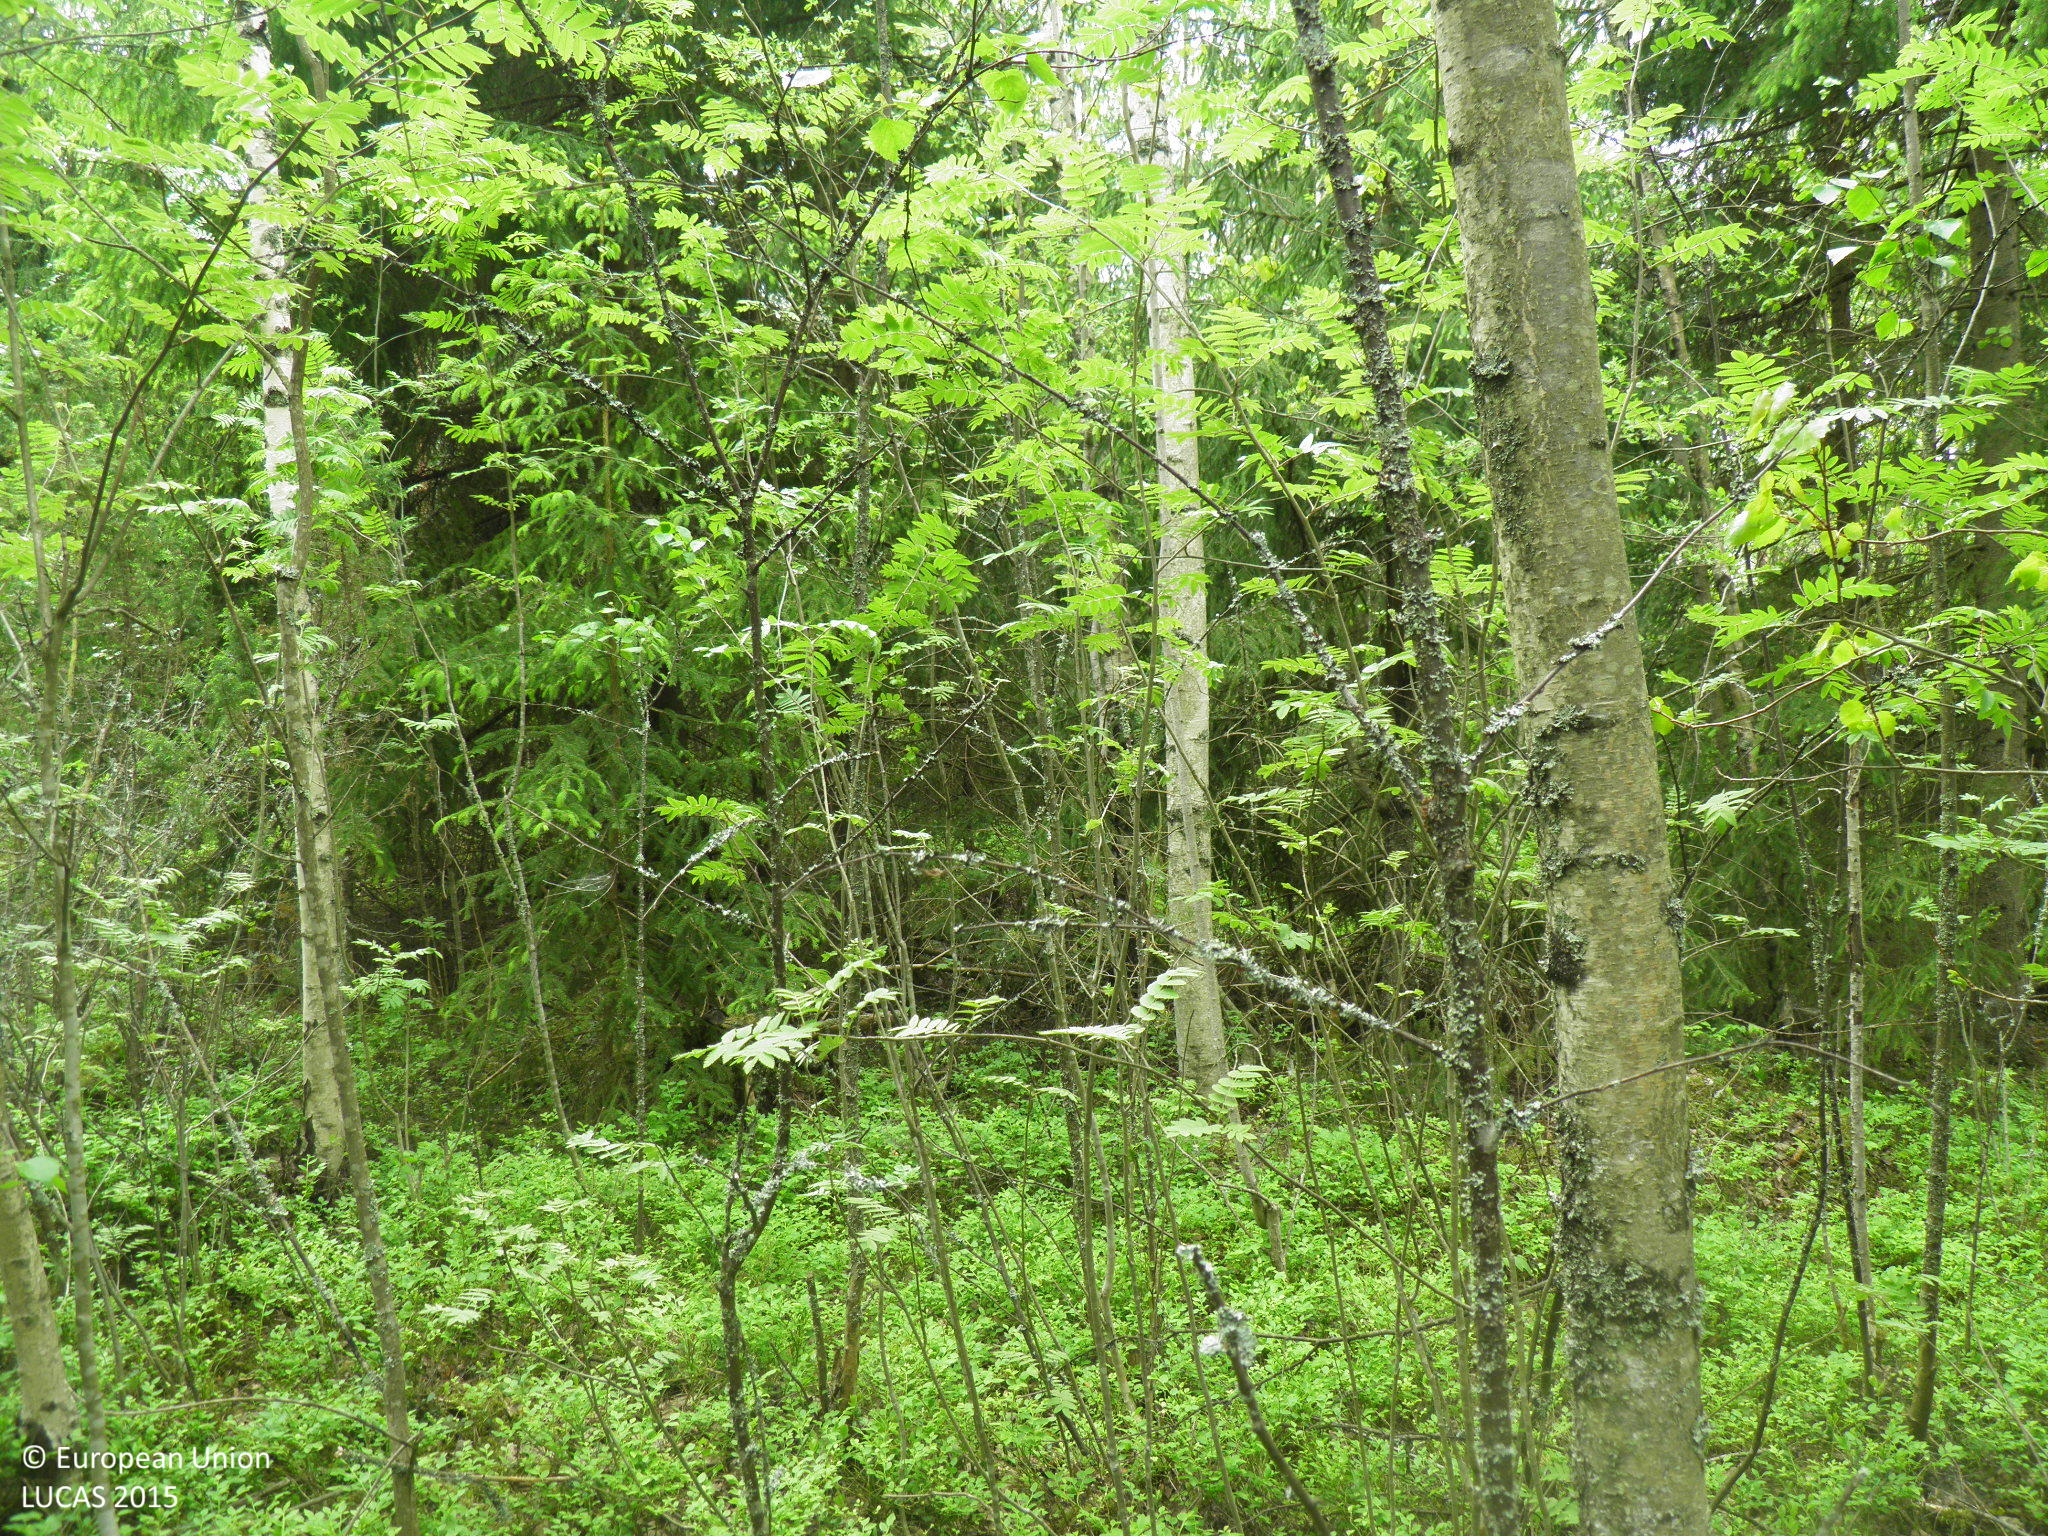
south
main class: Woodland
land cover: Other mixed woodland
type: boreal forest
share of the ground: > 75 %
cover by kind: coniferous forest trees 55 %, broadleaved forest trees 35 %, shrubs 5 %, herbaceous plants 5 %
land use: Forestry
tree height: > 5 m
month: June
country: FI
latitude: 60.4384
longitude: 21.9282
